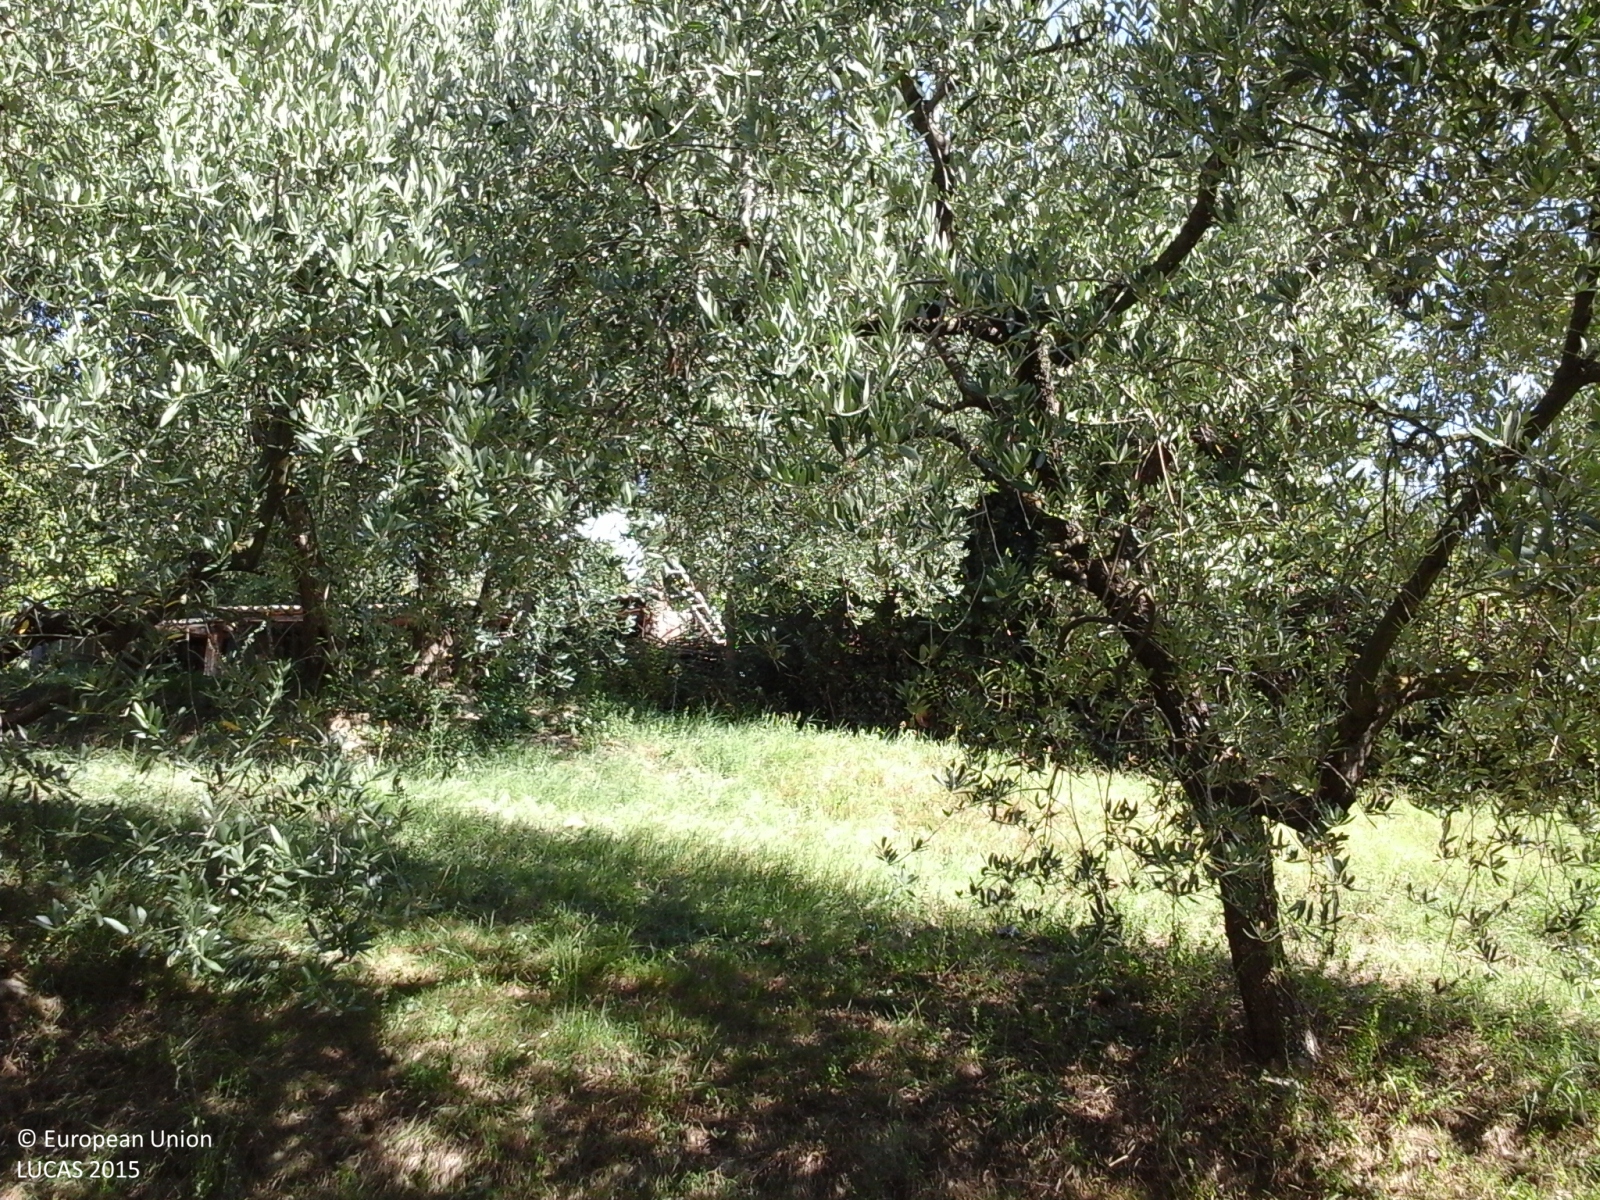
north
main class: Cropland
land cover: Olive groves
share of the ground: > 75 %
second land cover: Grassland without tree/shrub cover
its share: > 75 %
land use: Agriculture (excluding fallow land and kitchen gardens)
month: September
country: IT
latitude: 43.8777
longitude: 12.8682
